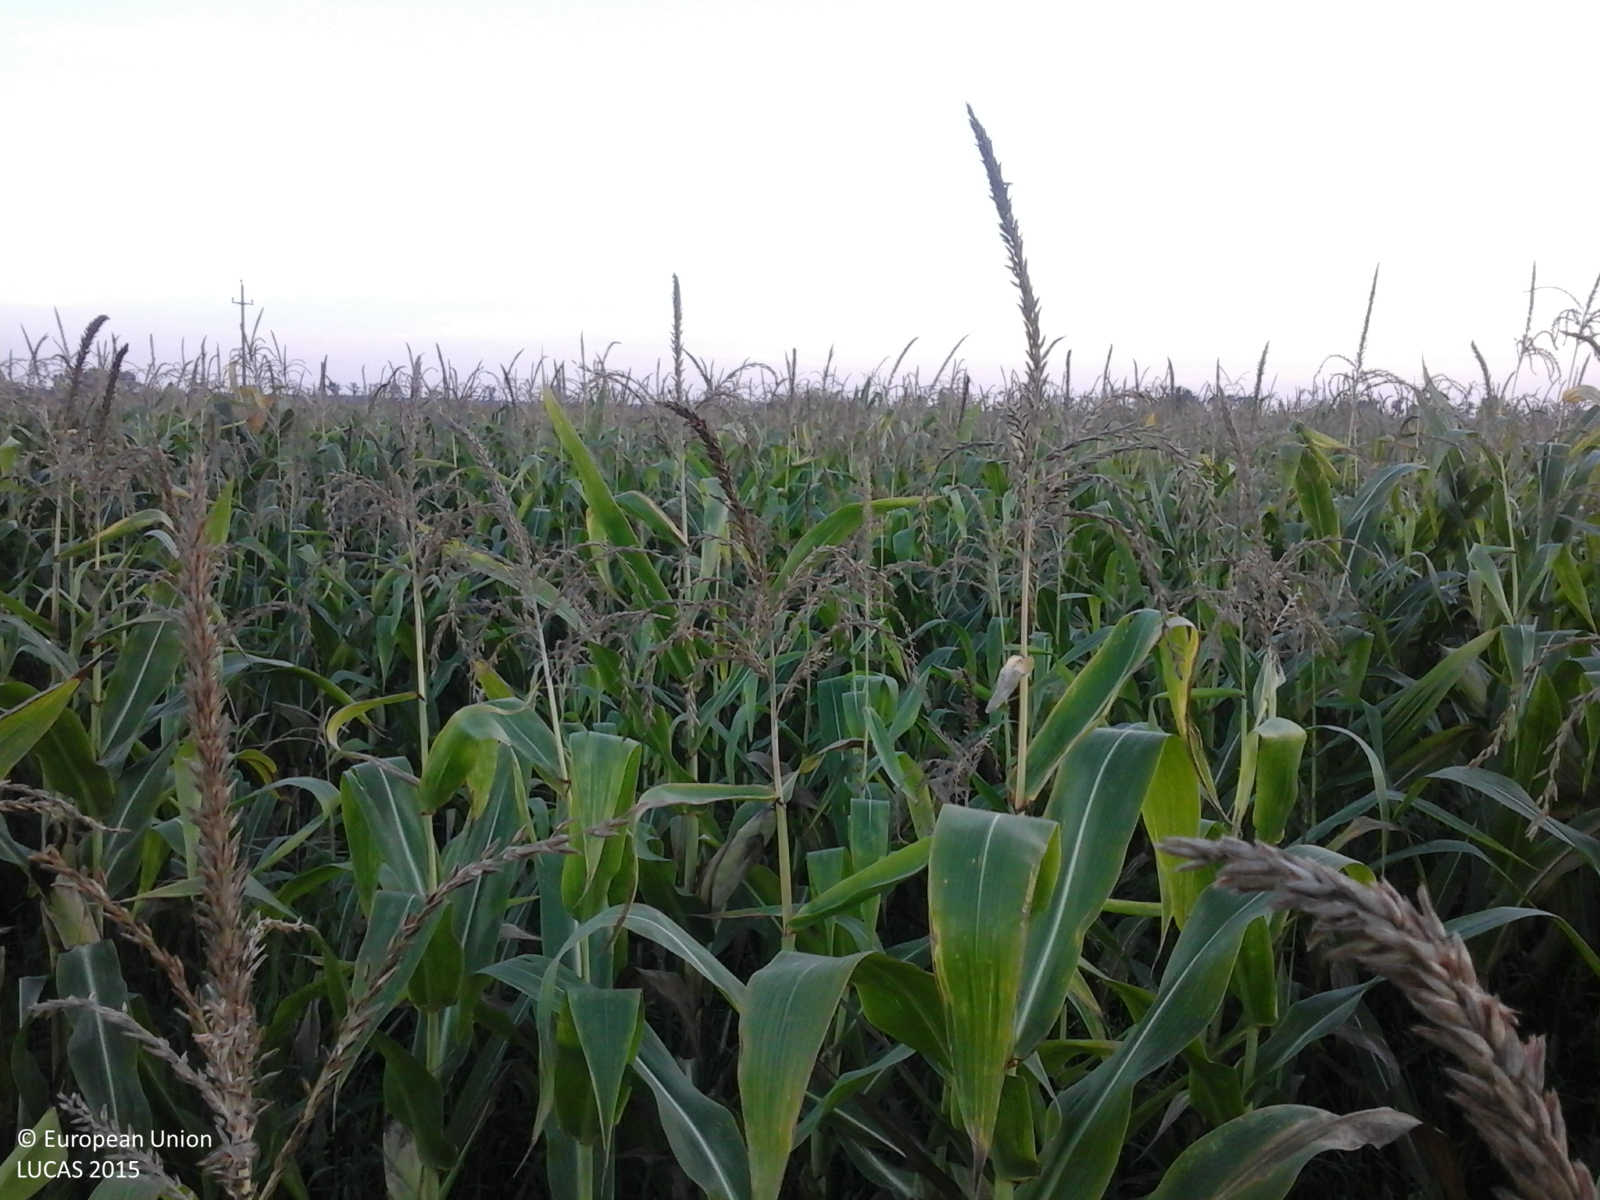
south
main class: Cropland
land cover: Maize
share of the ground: > 75 %
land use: Agriculture (excluding fallow land and kitchen gardens)
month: August
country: RO
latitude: 46.2134
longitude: 21.2194
